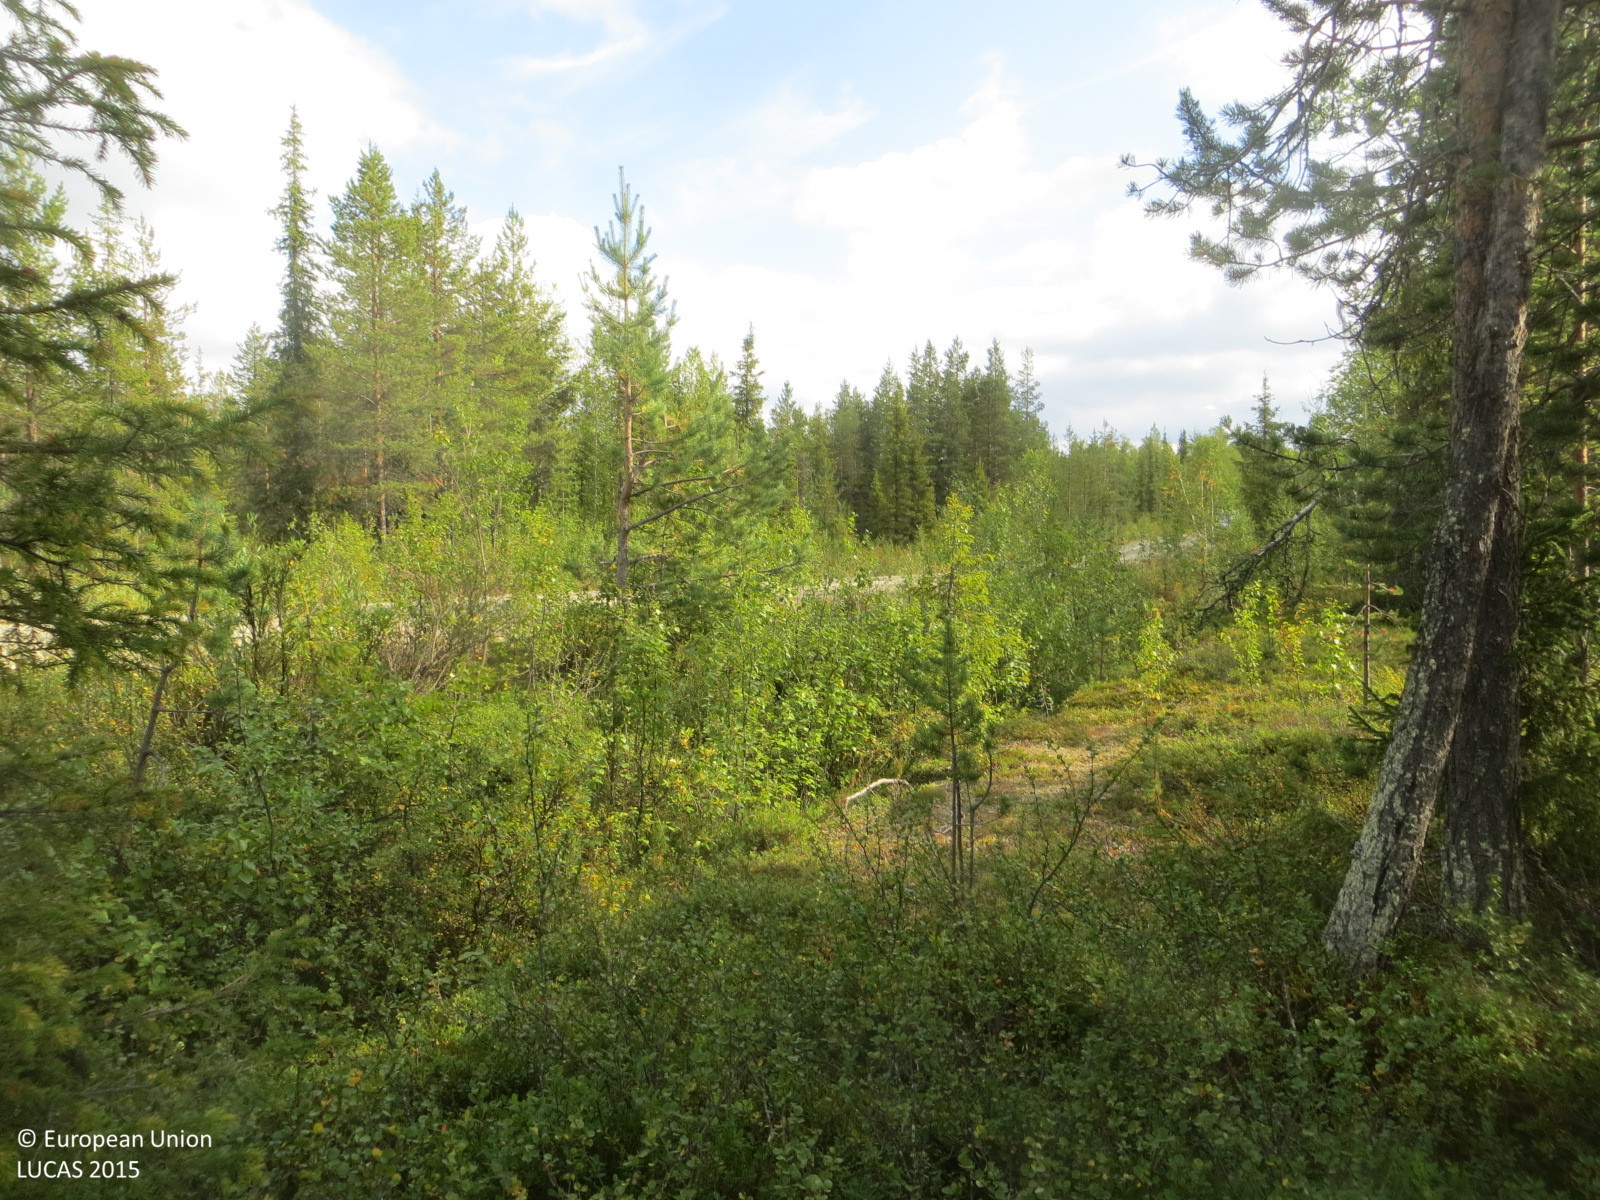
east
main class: Woodland
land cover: Pine dominated coniferous woodland
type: boreal forest
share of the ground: 50 - 75 %
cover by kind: coniferous forest trees 55 %, shrubs 35 %, broadleaved forest trees 10 %
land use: Forestry
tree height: > 5 m
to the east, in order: Pine dominated coniferous woodland; Ditches and canals; Abandoned hedges; Tracks; Ditches and canals; Abandoned hedges; Other mixed woodland; Pine dominated coniferous woodland; Ditches and canals; Other mixed woodland; Tracks; Other mixed woodland; Ditches and canals; Other mixed woodland; Other coniferous woodland
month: August
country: FI
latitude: 67.9839
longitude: 25.5077
